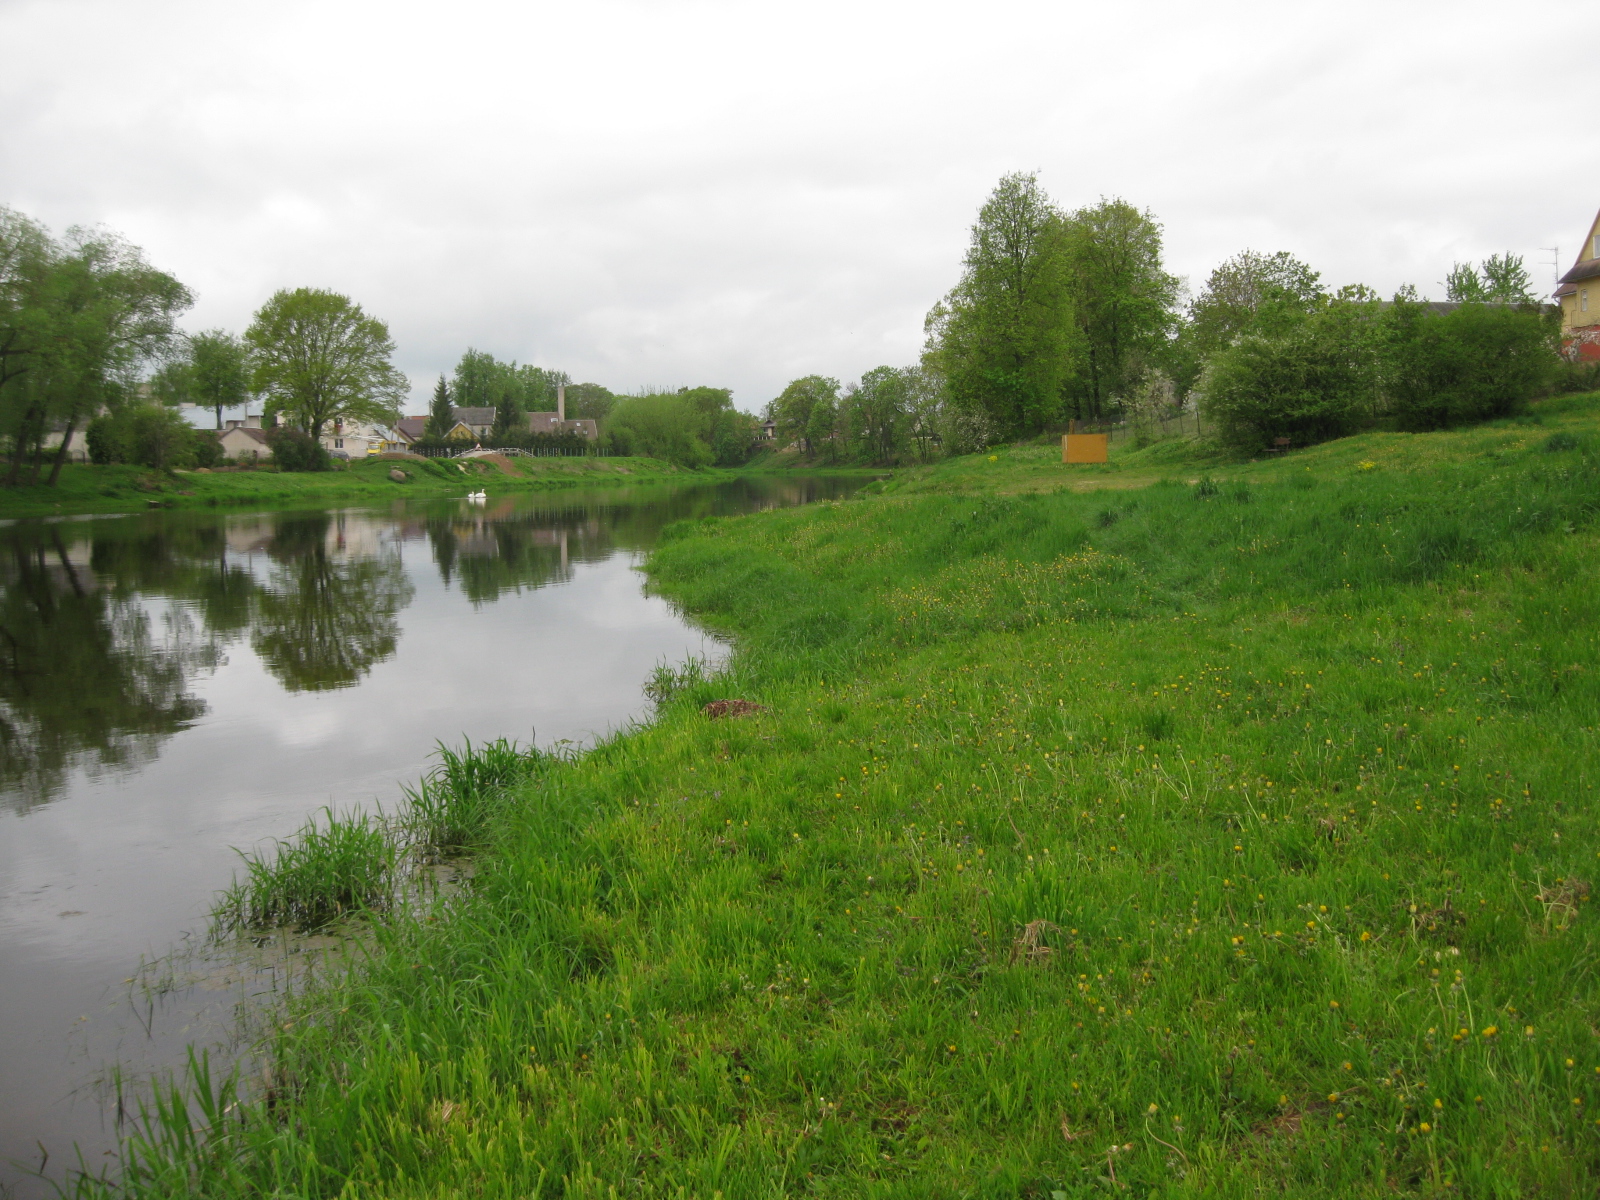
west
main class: Grassland
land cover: Grassland without tree/shrub cover
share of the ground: > 75 %
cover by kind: herbaceous plants 100 %
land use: Amenities, museums, leisure
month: May
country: LT
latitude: 56.0642
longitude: 24.4065
